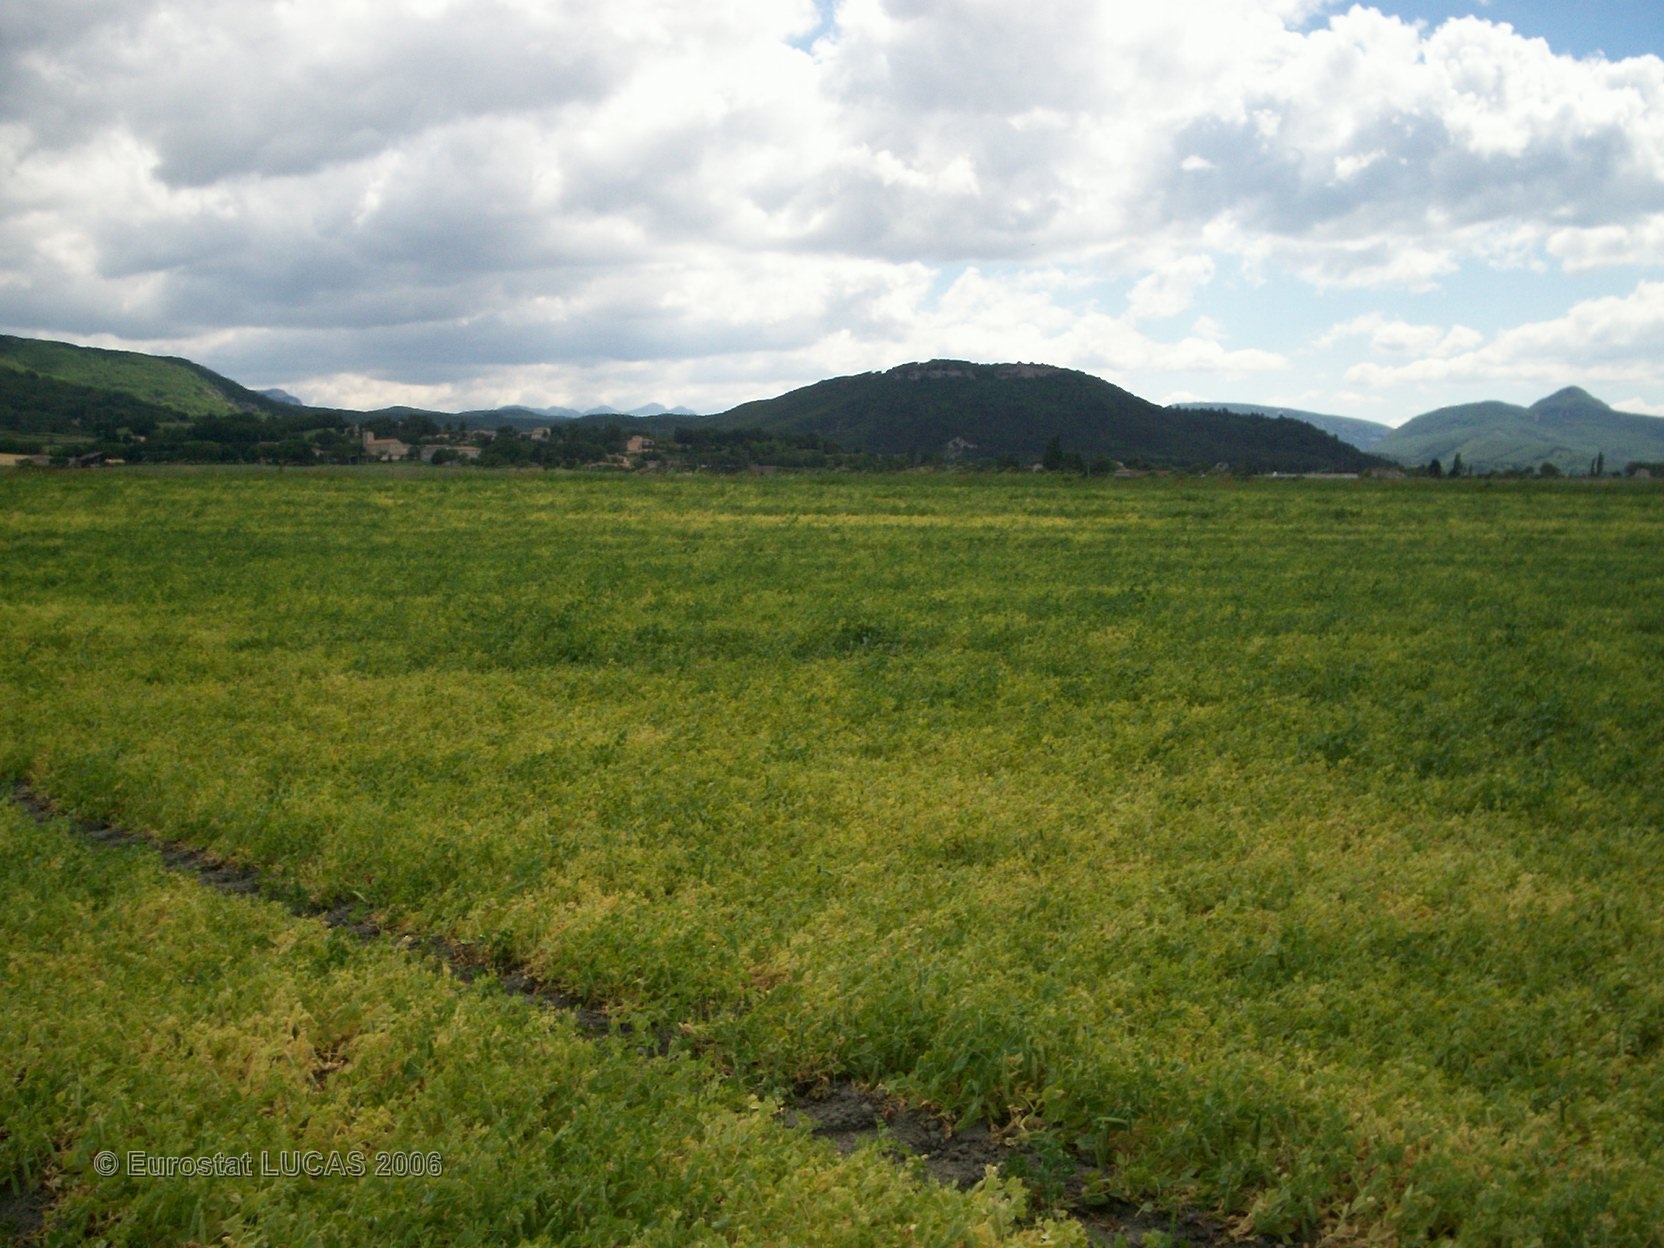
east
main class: Cropland
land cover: Dry pulses
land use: Agriculture (excluding fallow land and kitchen gardens)
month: May
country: FR
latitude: 44.6420
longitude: 4.9257
